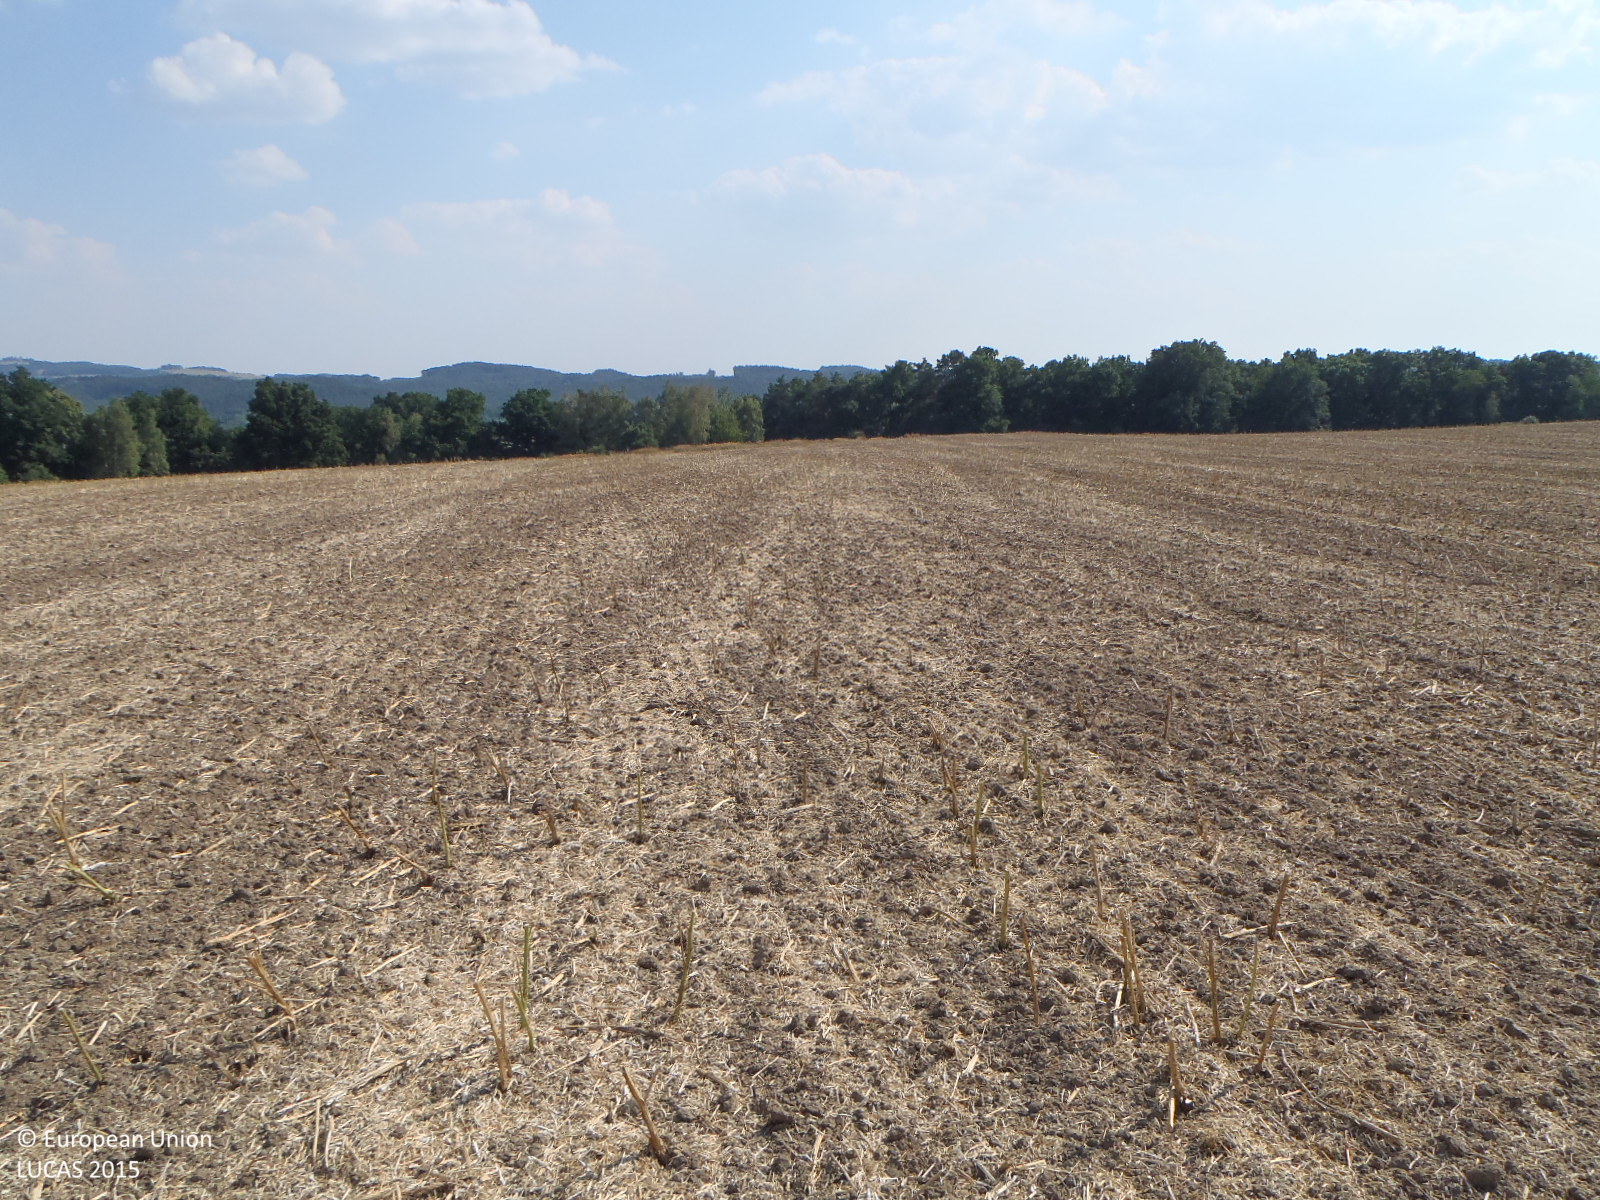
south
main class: Cropland
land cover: Rape and turnip rape
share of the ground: 50 - 75 %
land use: Agriculture (excluding fallow land and kitchen gardens)
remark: Harvested field
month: August
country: CZ
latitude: 50.6341
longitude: 14.5404
